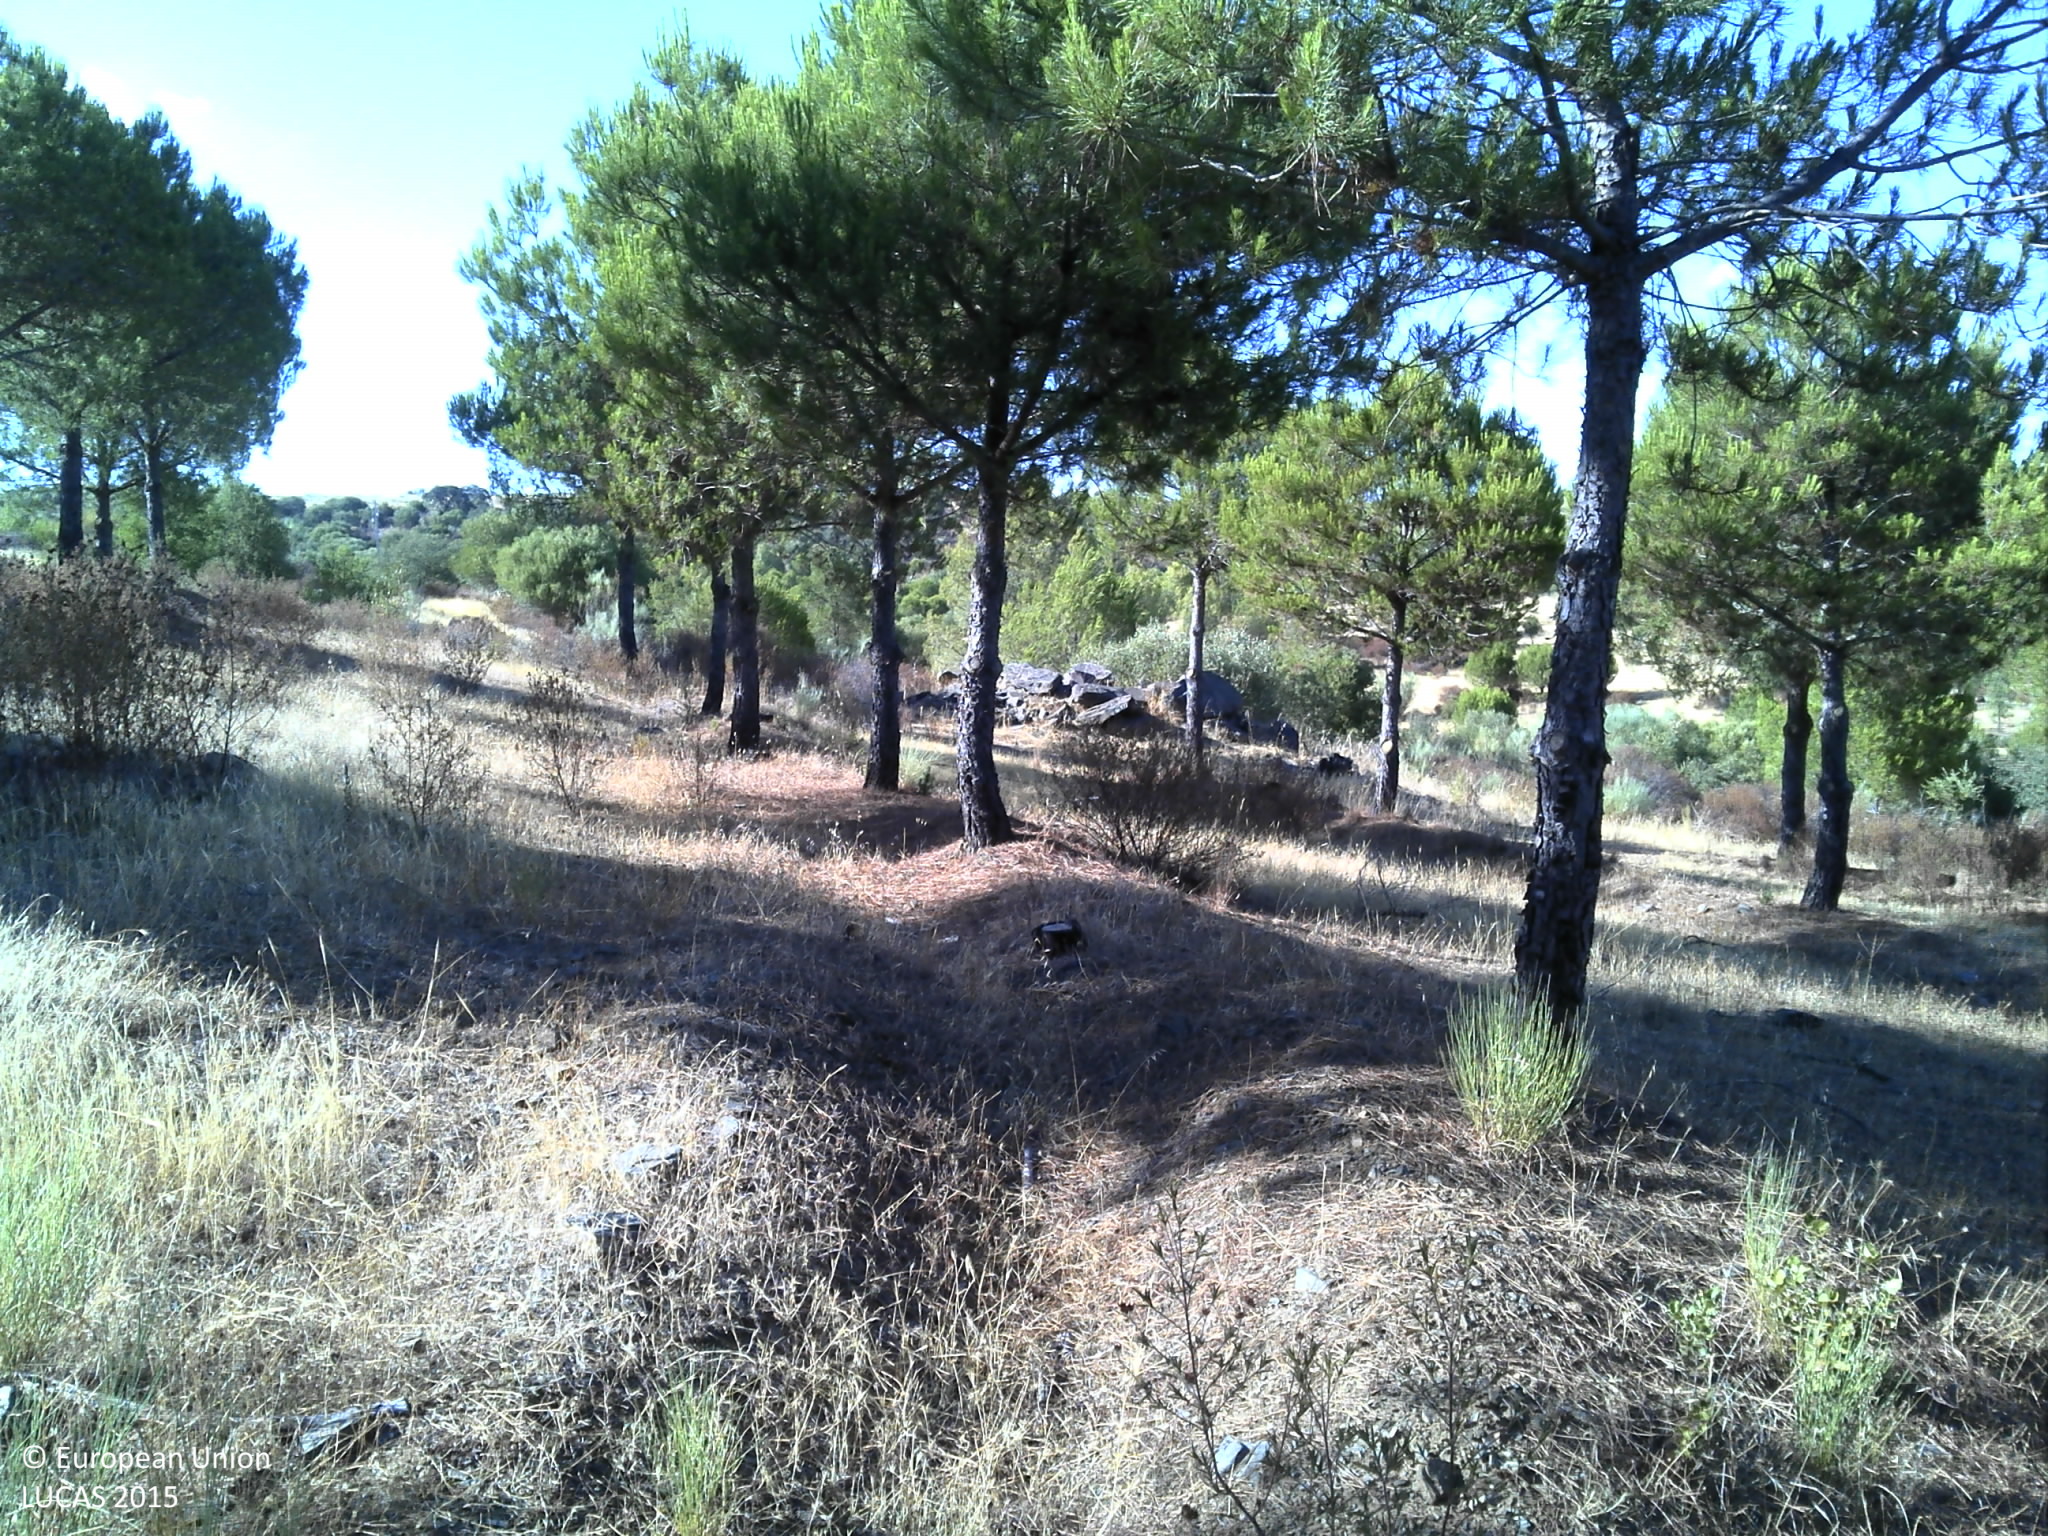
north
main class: Woodland
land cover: Pine dominated coniferous woodland
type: coniferous forest of the mediterranean region
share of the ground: > 75 %
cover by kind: coniferous forest trees 85 %, shrubs 5 %, herbaceous plants 5 %, unconsolidated bare surface 5 %
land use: Forestry
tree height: < 5 m
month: July
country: PT
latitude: 37.9247
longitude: -7.6893
